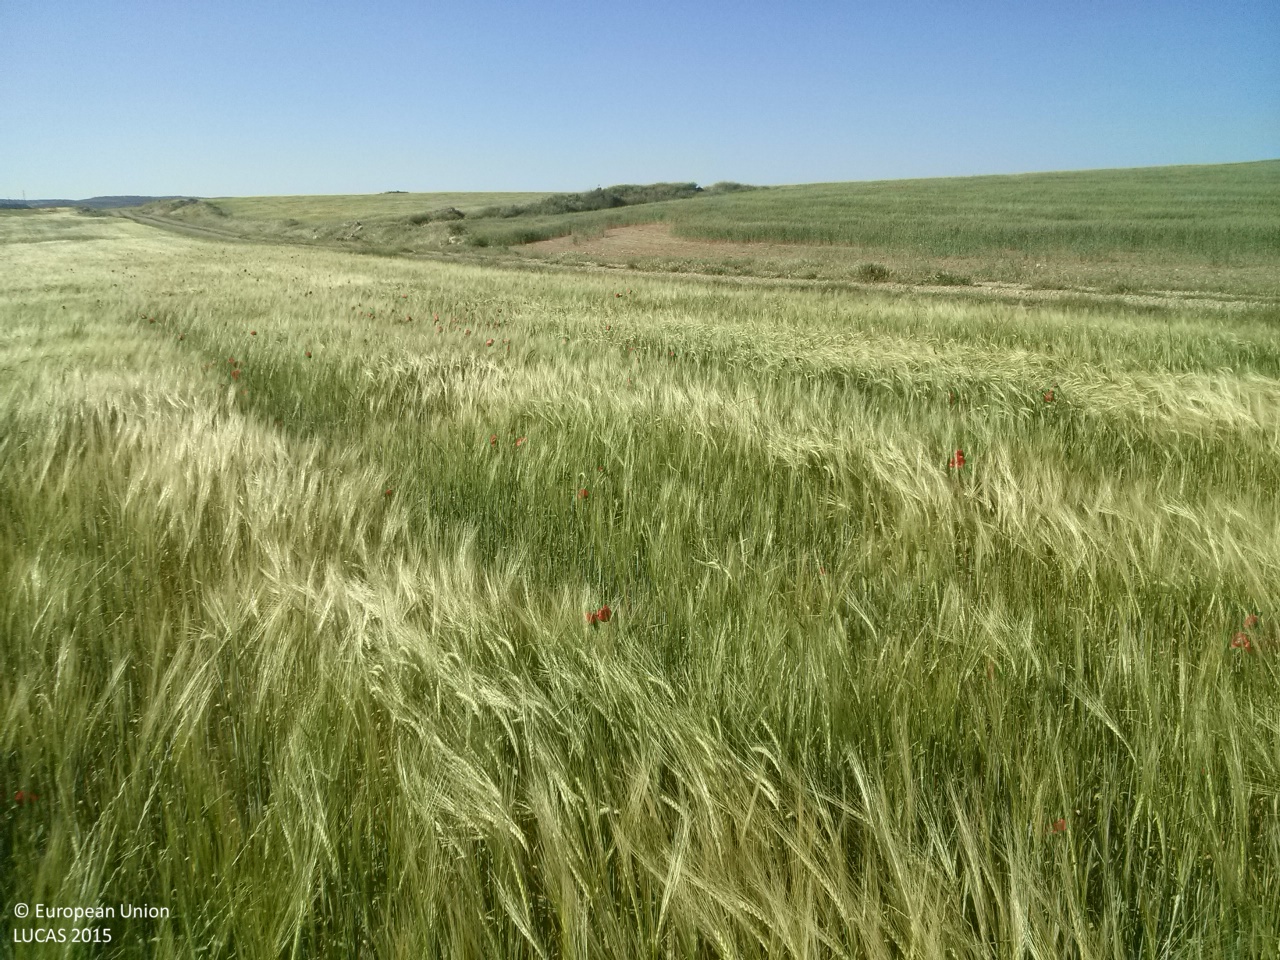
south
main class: Cropland
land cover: Barley
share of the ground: > 75 %
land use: Agriculture (excluding fallow land and kitchen gardens)
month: May
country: ES
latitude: 40.1679
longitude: -2.7158
